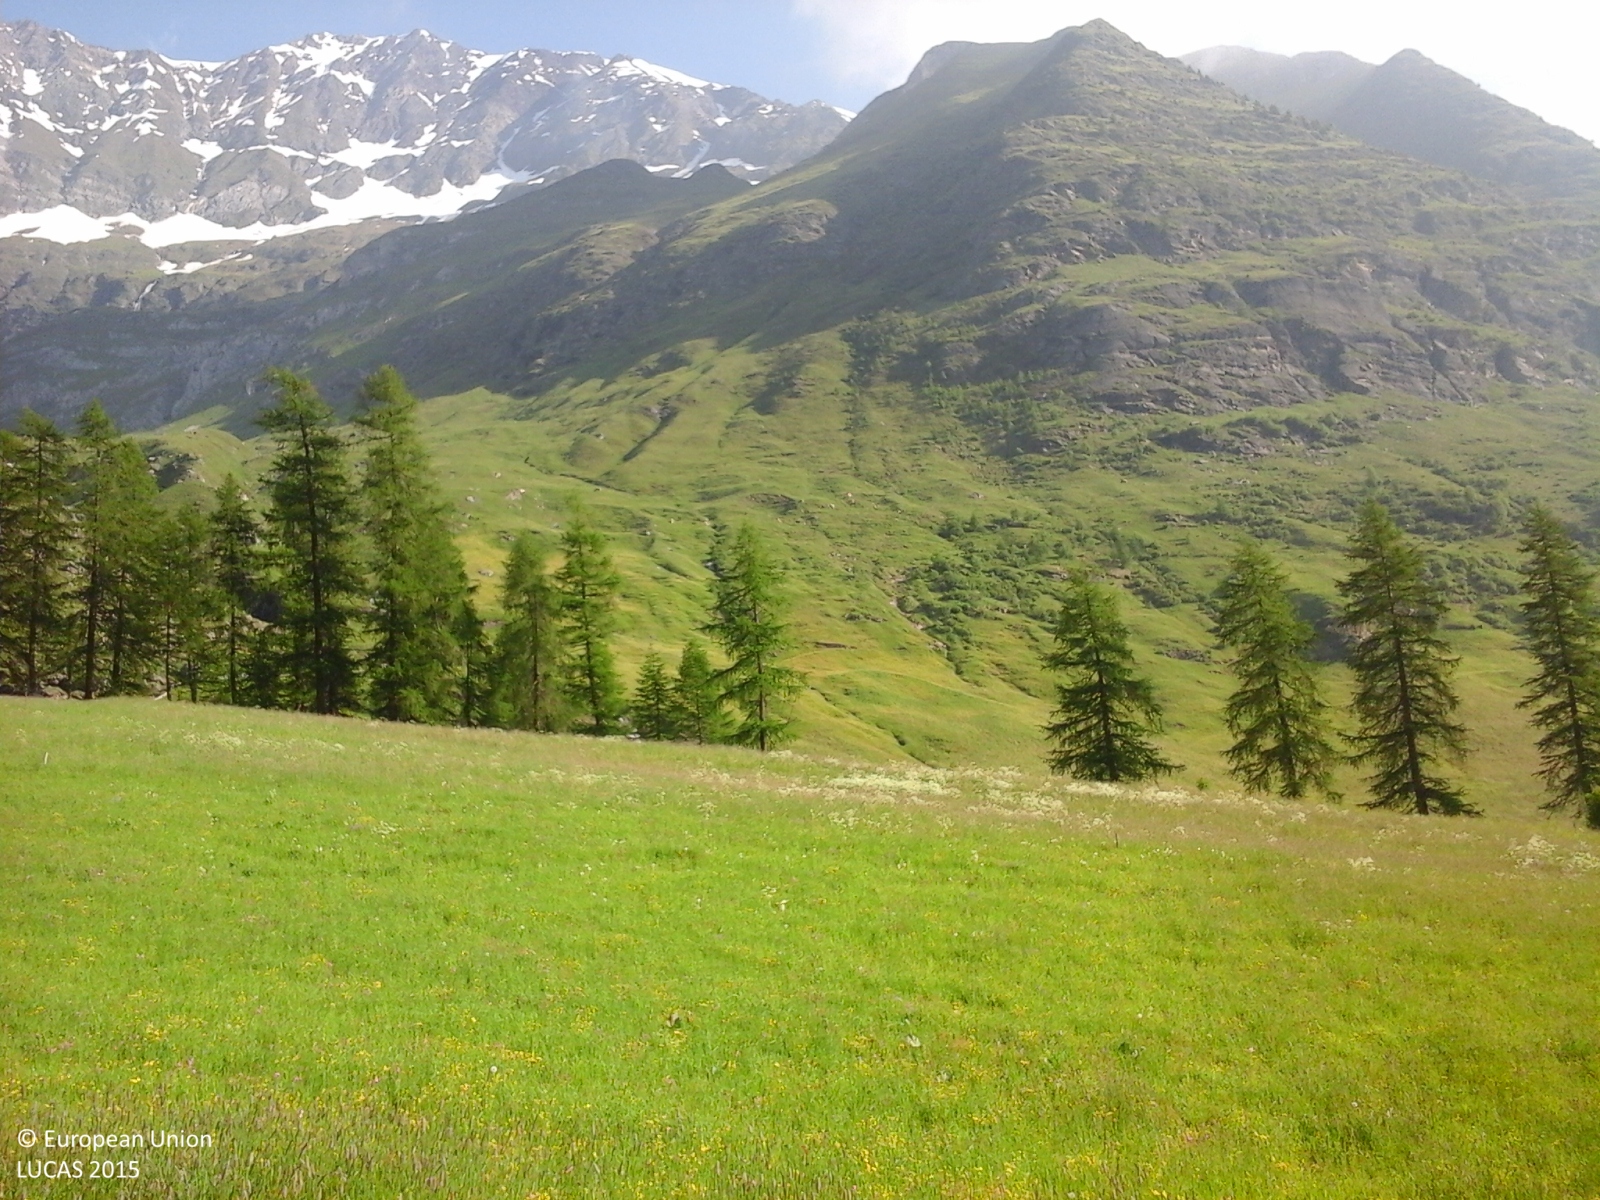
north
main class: Grassland
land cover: Grassland without tree/shrub cover
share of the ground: > 75 %
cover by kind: herbaceous plants 100 %
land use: Agriculture (excluding fallow land and kitchen gardens)
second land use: Sport
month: June
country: IT
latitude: 46.7960
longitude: 11.0862
